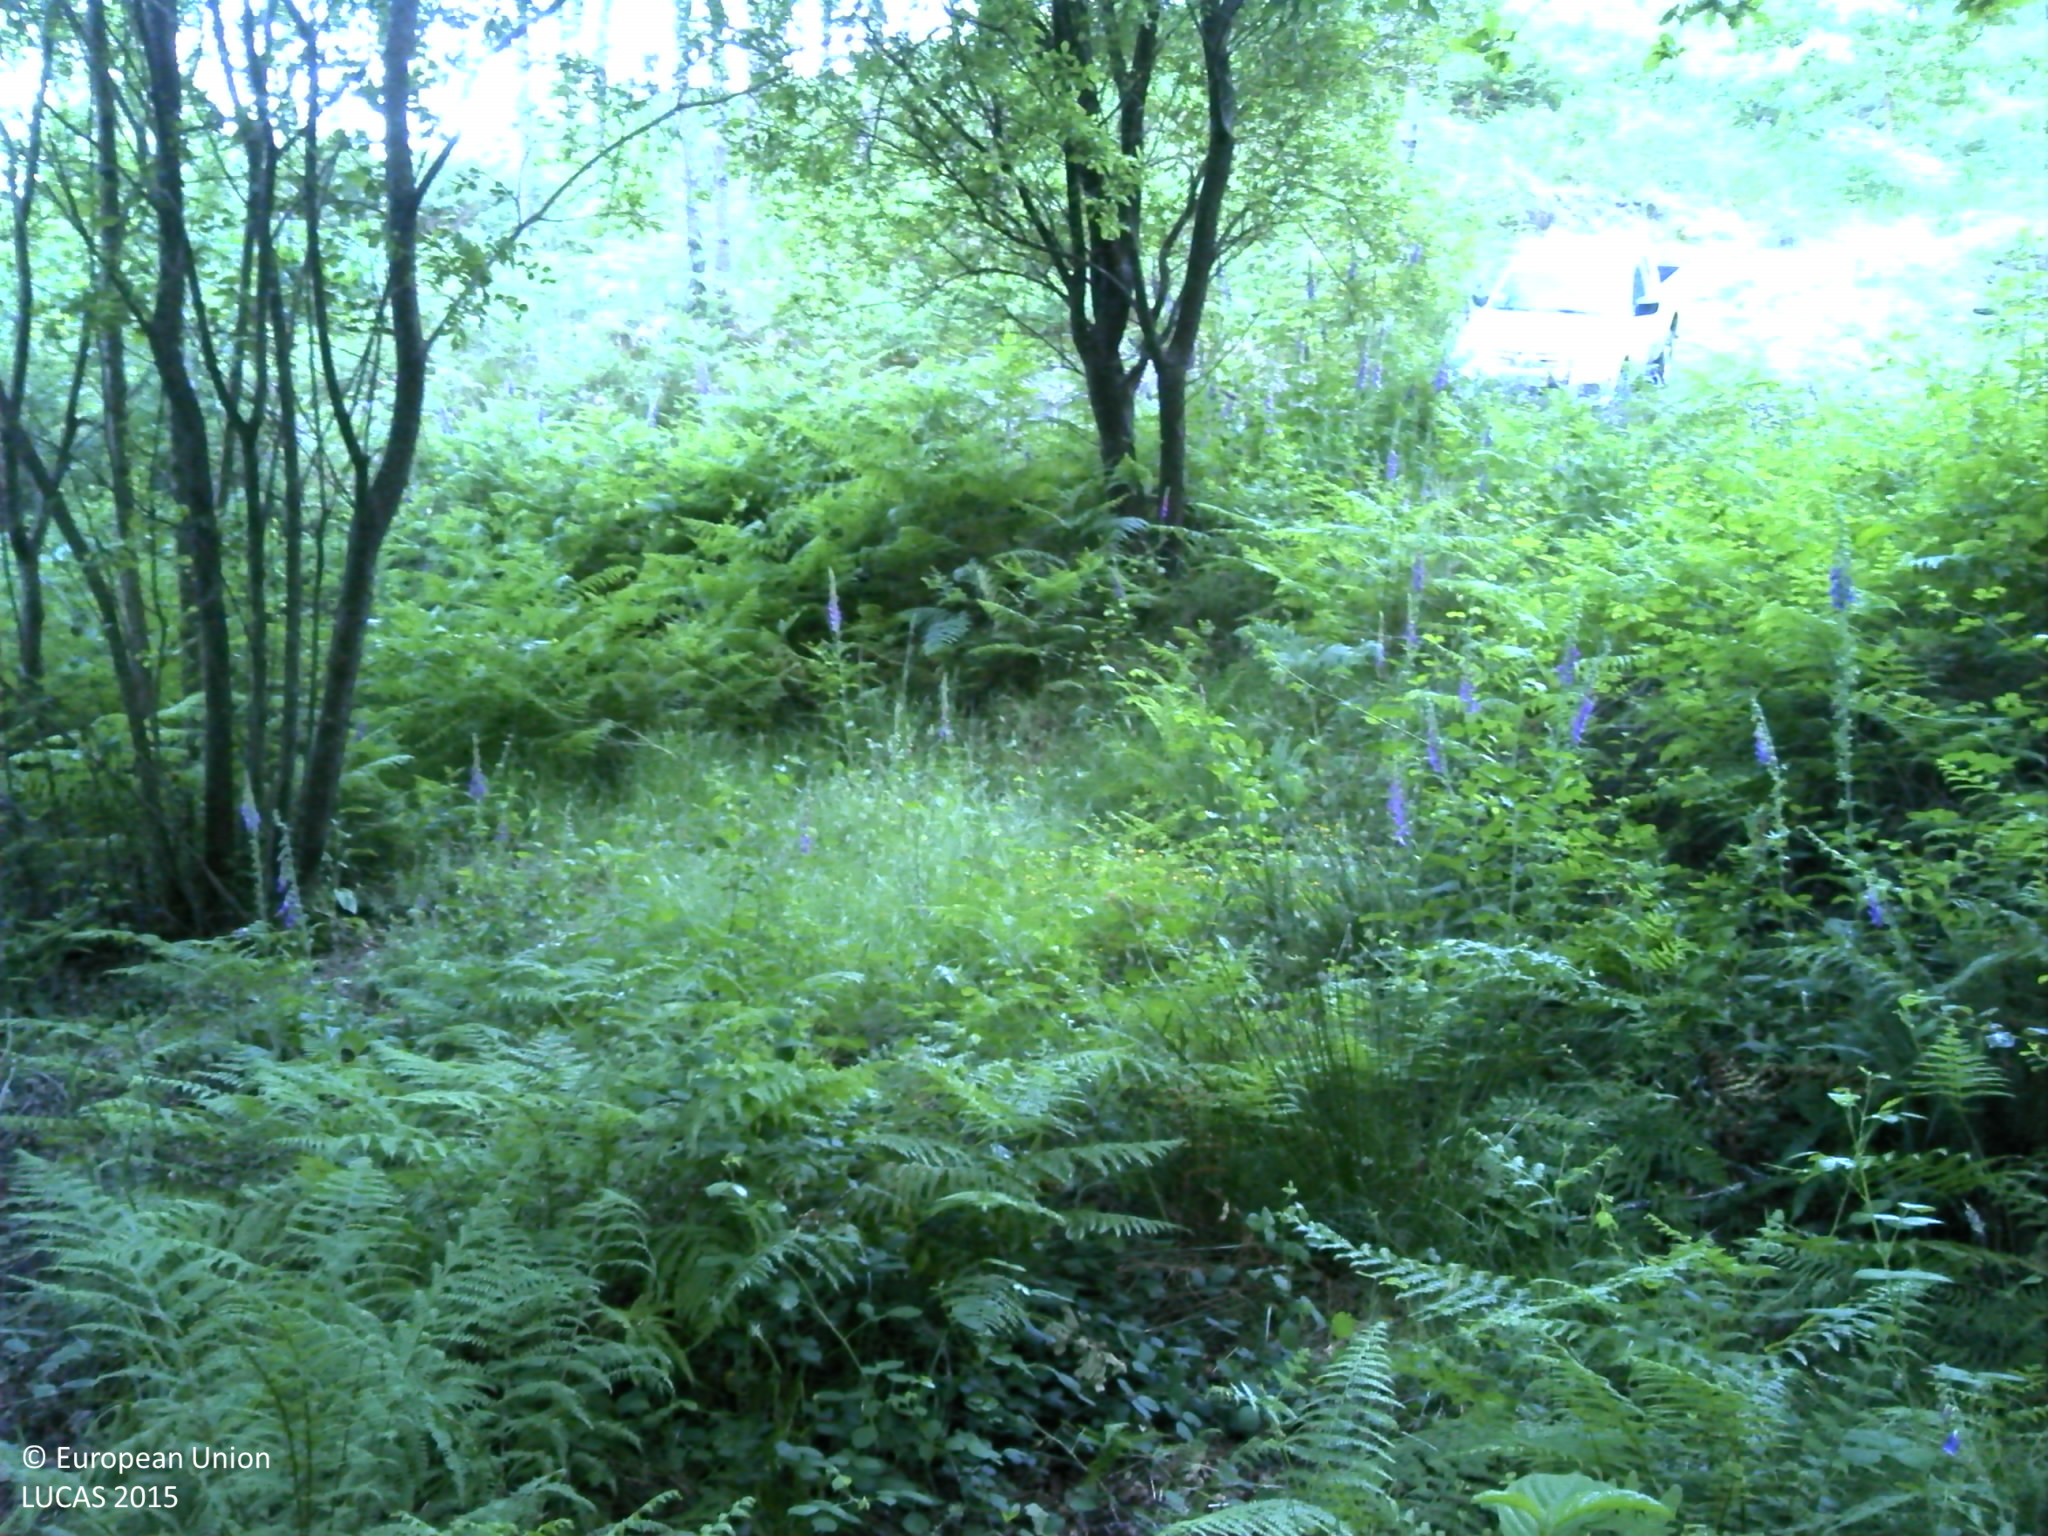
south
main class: Woodland
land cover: Broadleaved woodland
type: acidophilous oak and oak-birch forest
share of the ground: 50 - 75 %
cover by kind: broadleaved forest trees 75 %, shrubs 20 %, herbaceous plants 5 %
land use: Forestry
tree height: > 5 m
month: May
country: PT
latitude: 41.9375
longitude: -8.6567
